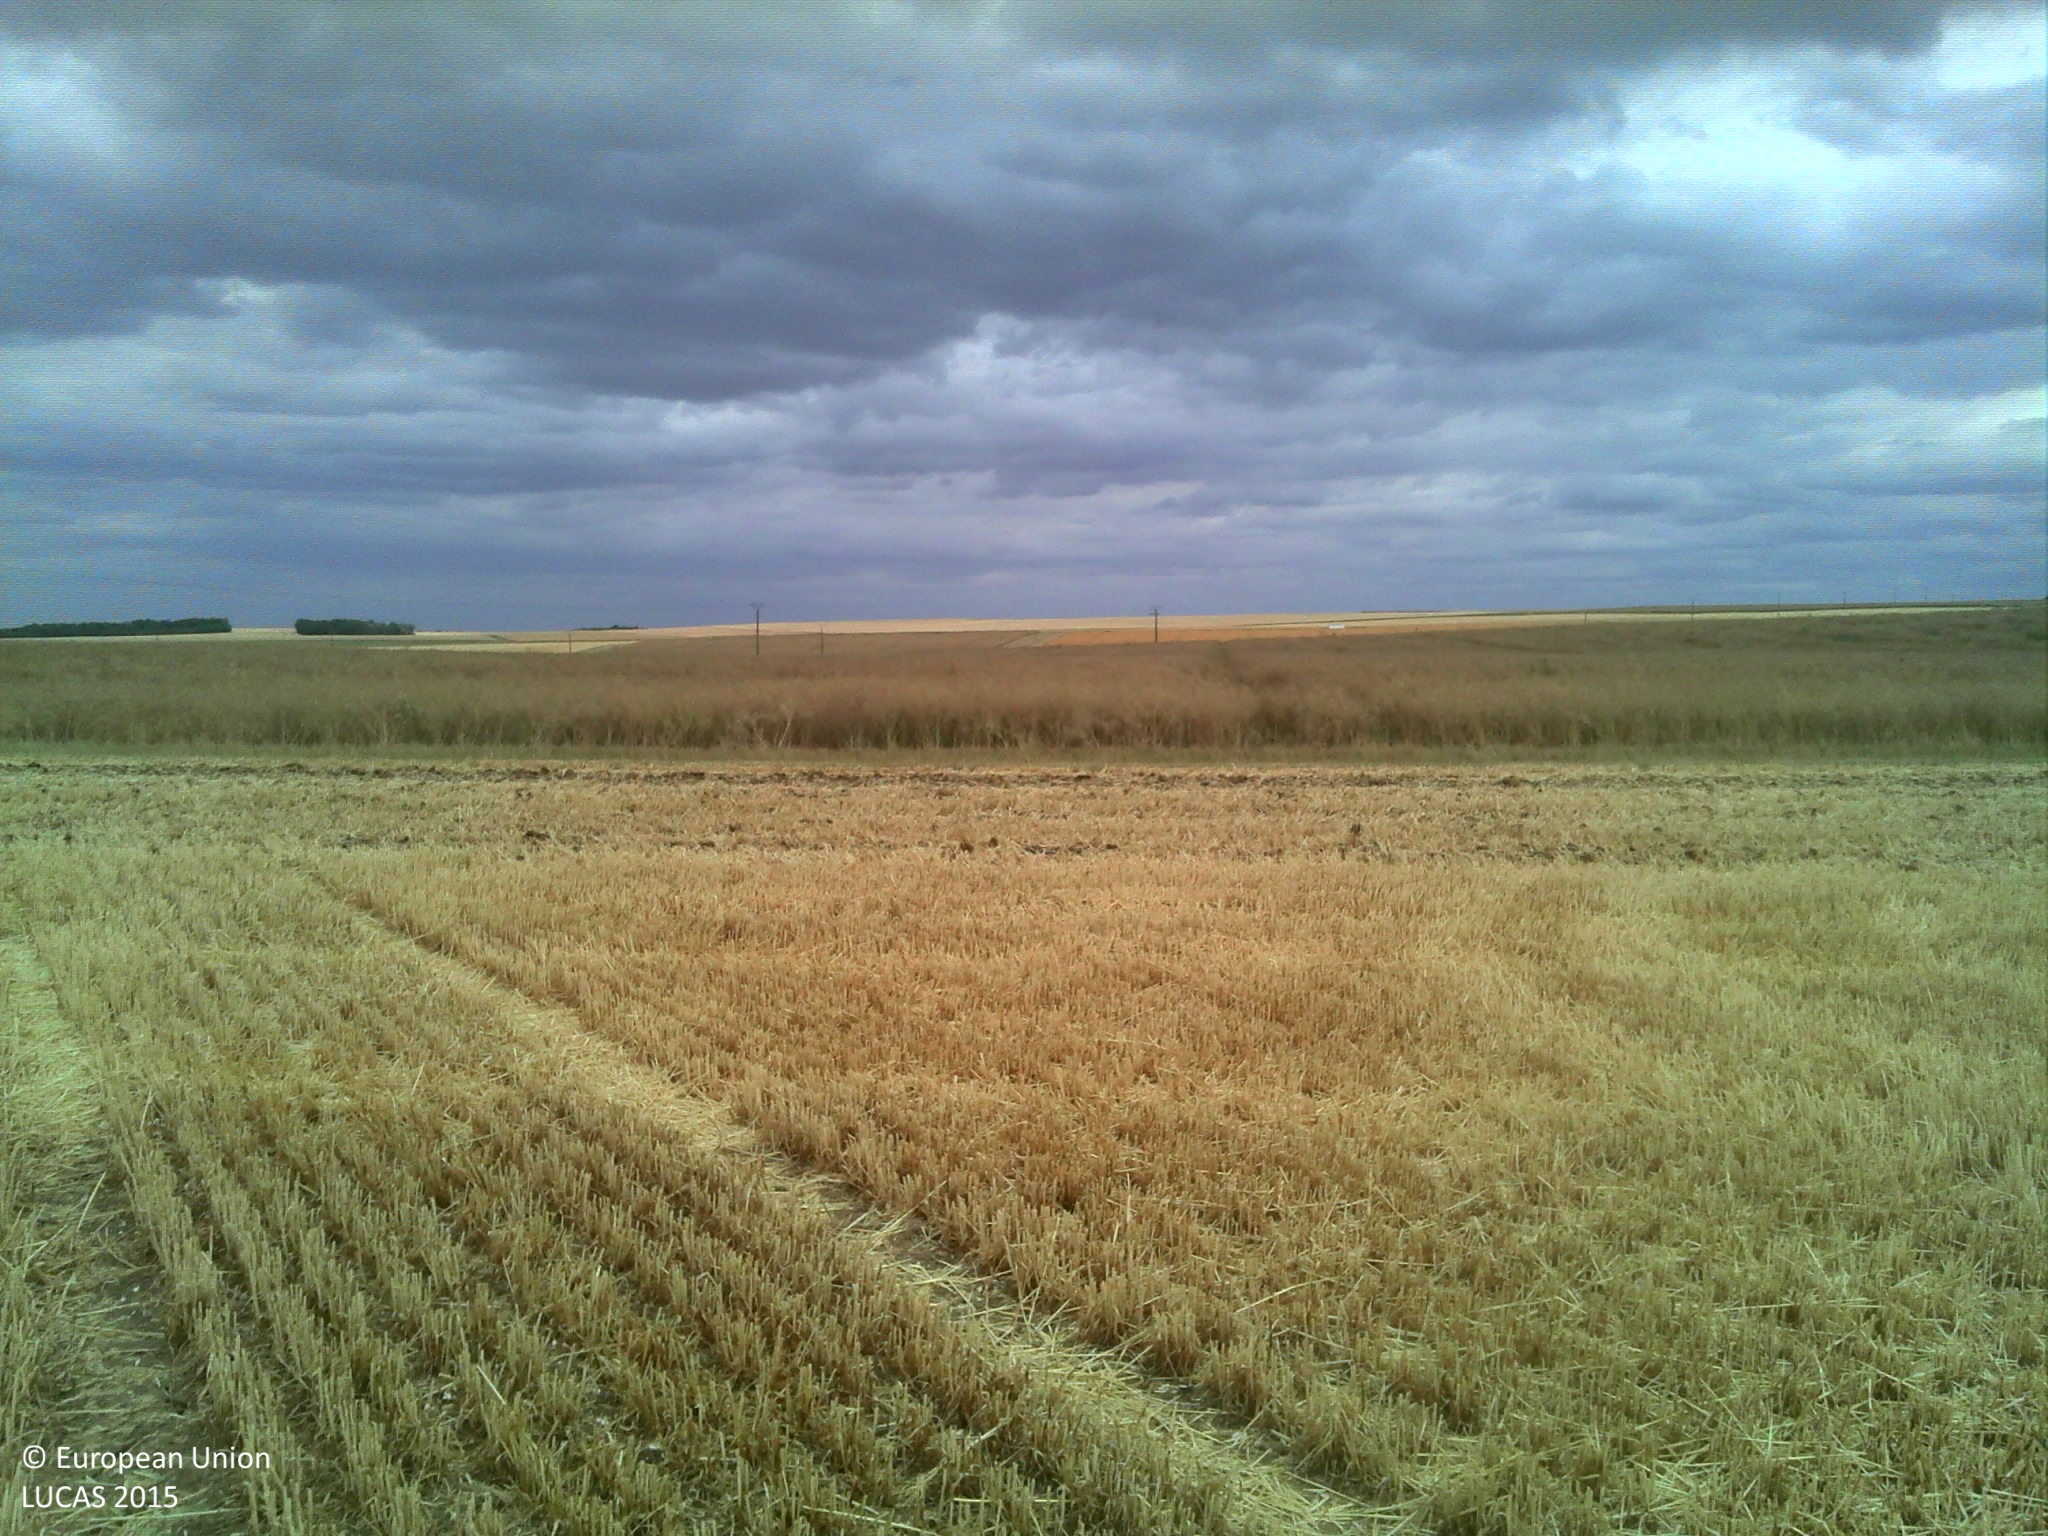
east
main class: Cropland
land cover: Common wheat
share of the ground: > 75 %
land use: Agriculture (excluding fallow land and kitchen gardens)
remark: Harvested field
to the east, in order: Common wheat; Tracks; Rape and turnip rape
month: July
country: FR
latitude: 48.3667
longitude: 3.3660
